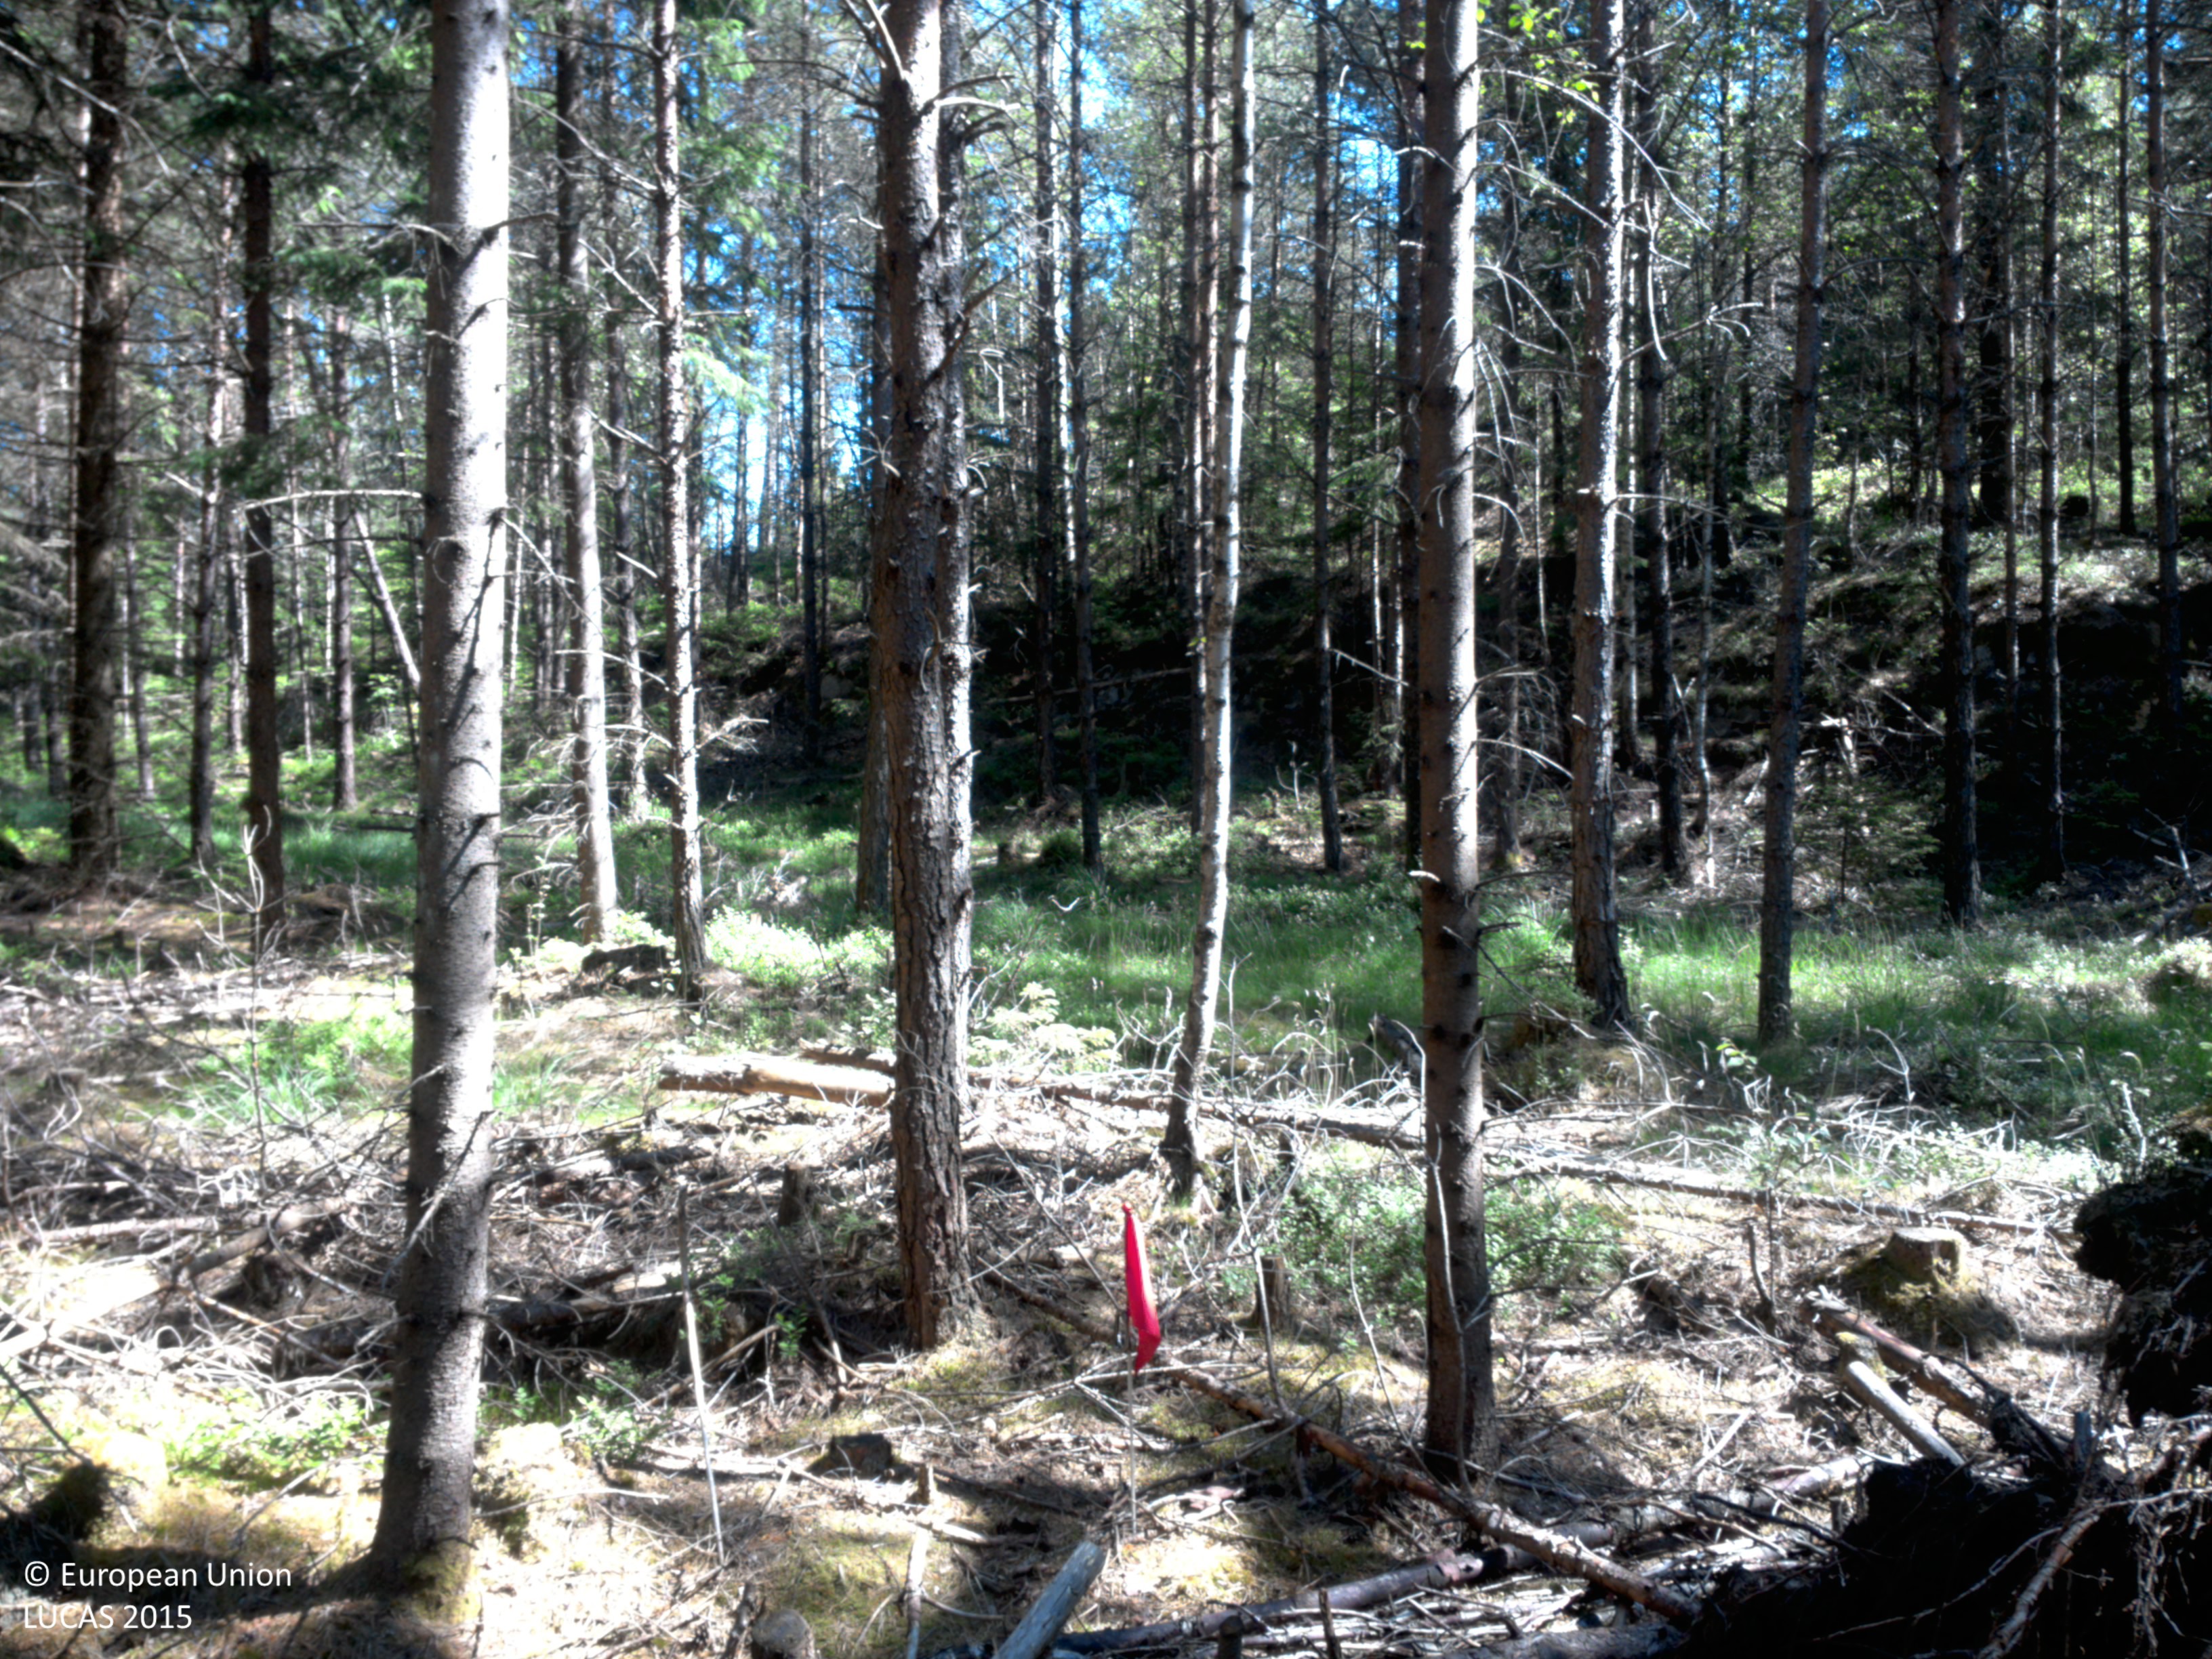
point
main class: Woodland
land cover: Other coniferous woodland
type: boreal forest
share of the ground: 50 - 75 %
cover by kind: coniferous forest trees 50 %, herbaceous plants 30 %, lichens and mosses 10 %, broadleaved forest trees 5 %, shrubs 5 %
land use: Forestry
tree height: > 5 m
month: July
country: SE
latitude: 58.5124
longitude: 11.8671
